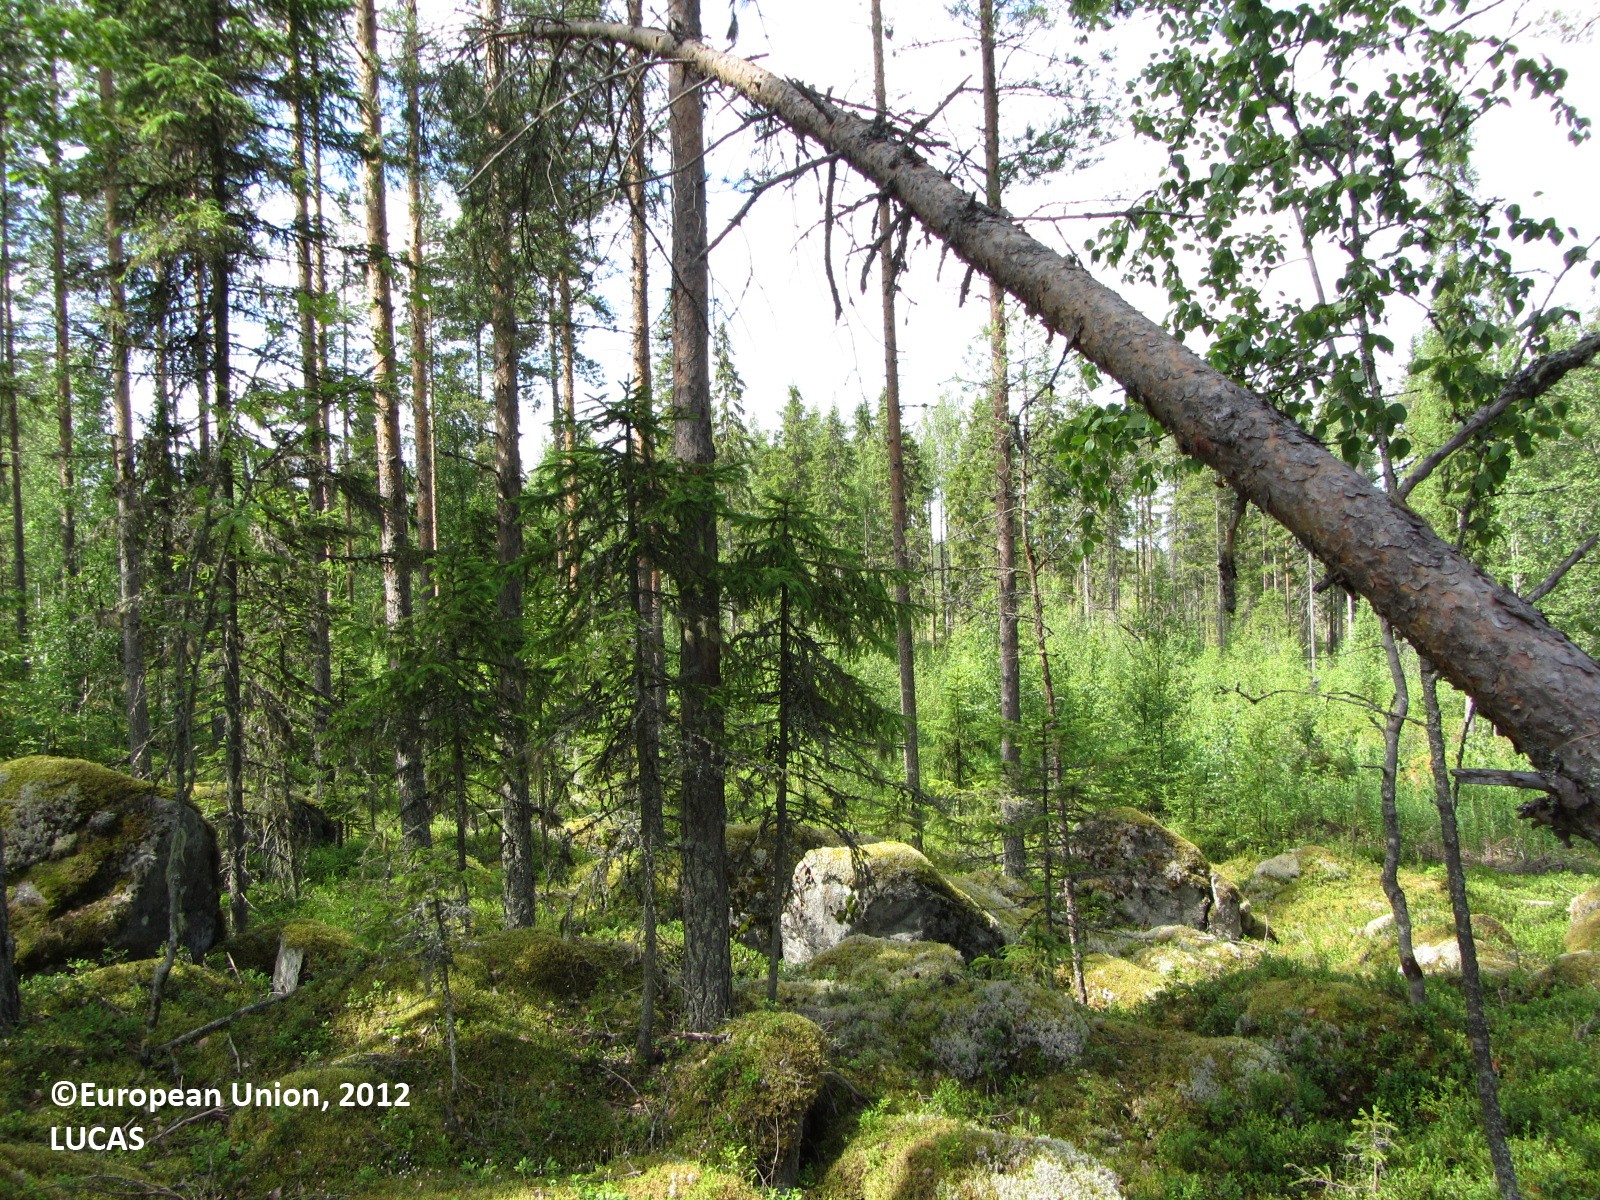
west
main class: Woodland
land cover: Pine dominated coniferous woodland
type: boreal forest
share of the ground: 50 - 75 %
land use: Forestry
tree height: > 5 m
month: July
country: FI
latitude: 63.6730
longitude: 25.4375
